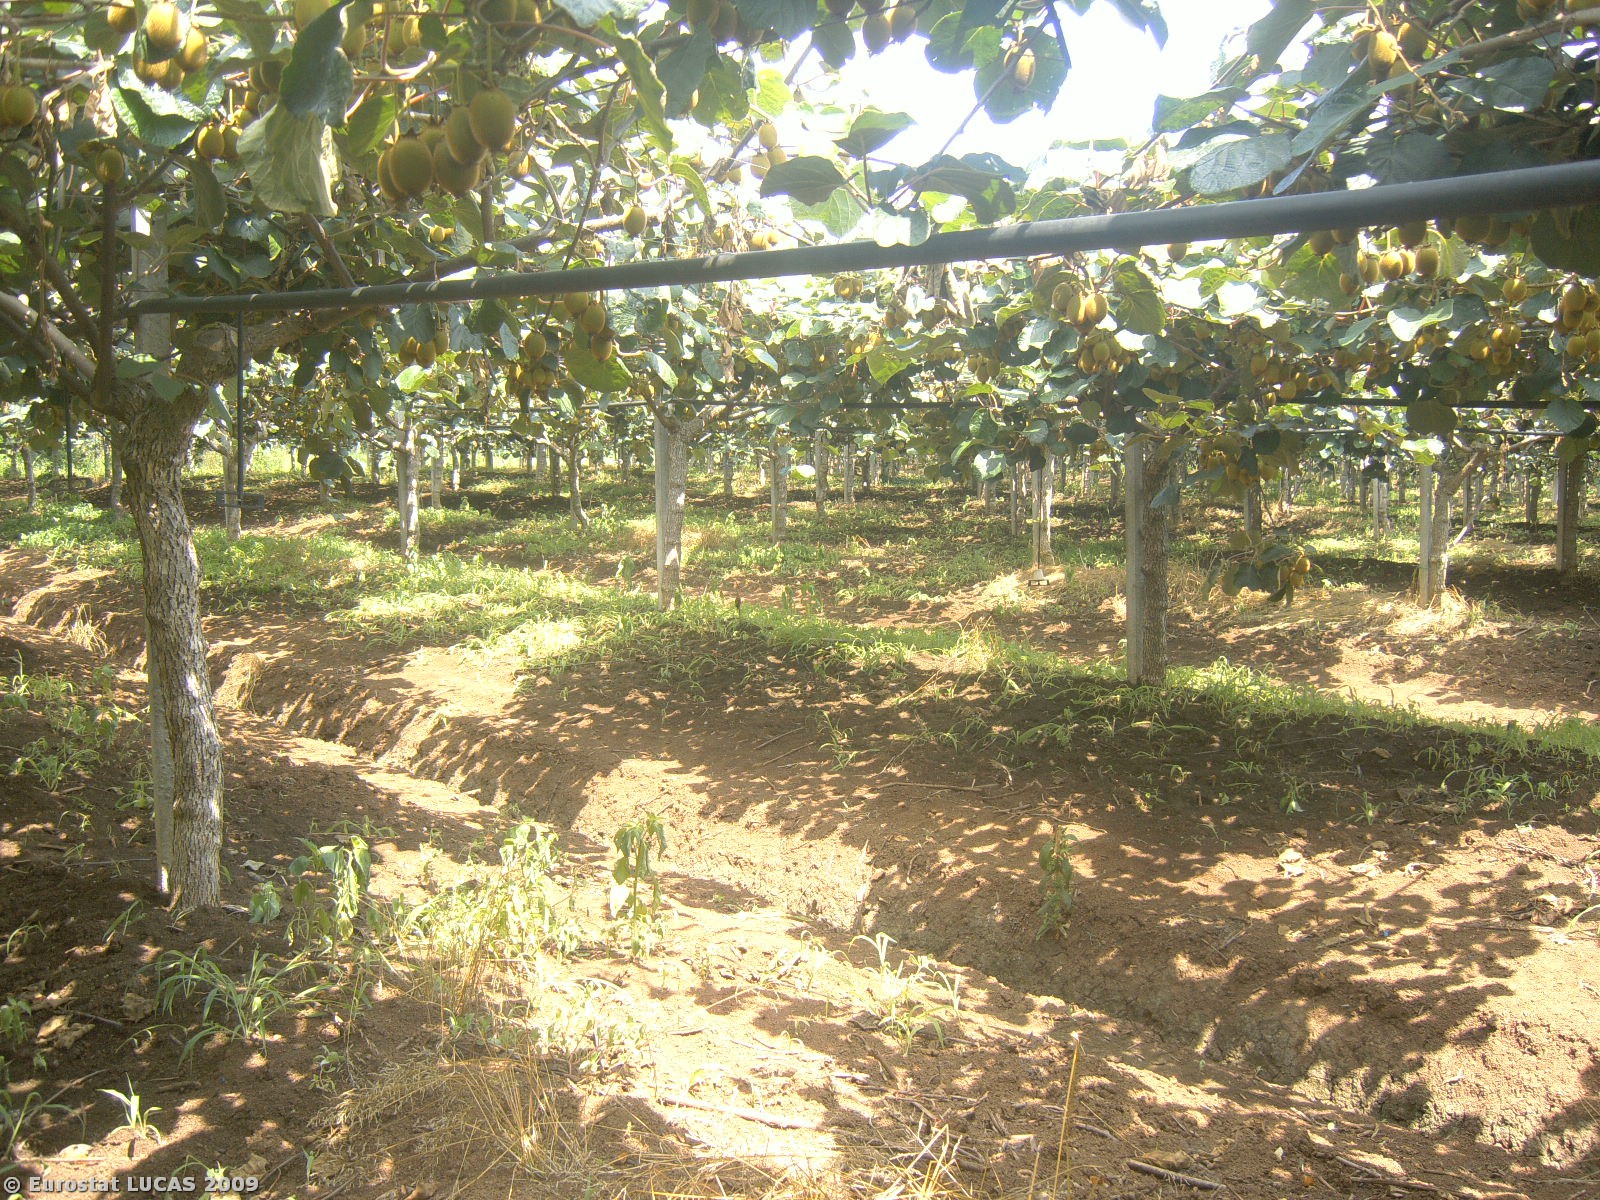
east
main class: Cropland
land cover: Other fruit trees and berries
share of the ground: > 75 %
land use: Agriculture (excluding fallow land and kitchen gardens)
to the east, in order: Other fruit trees and berries; Tracks; Grass margins; Ditches and canals; Grass margins; Tracks
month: June
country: IT
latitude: 41.5505
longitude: 12.7346
